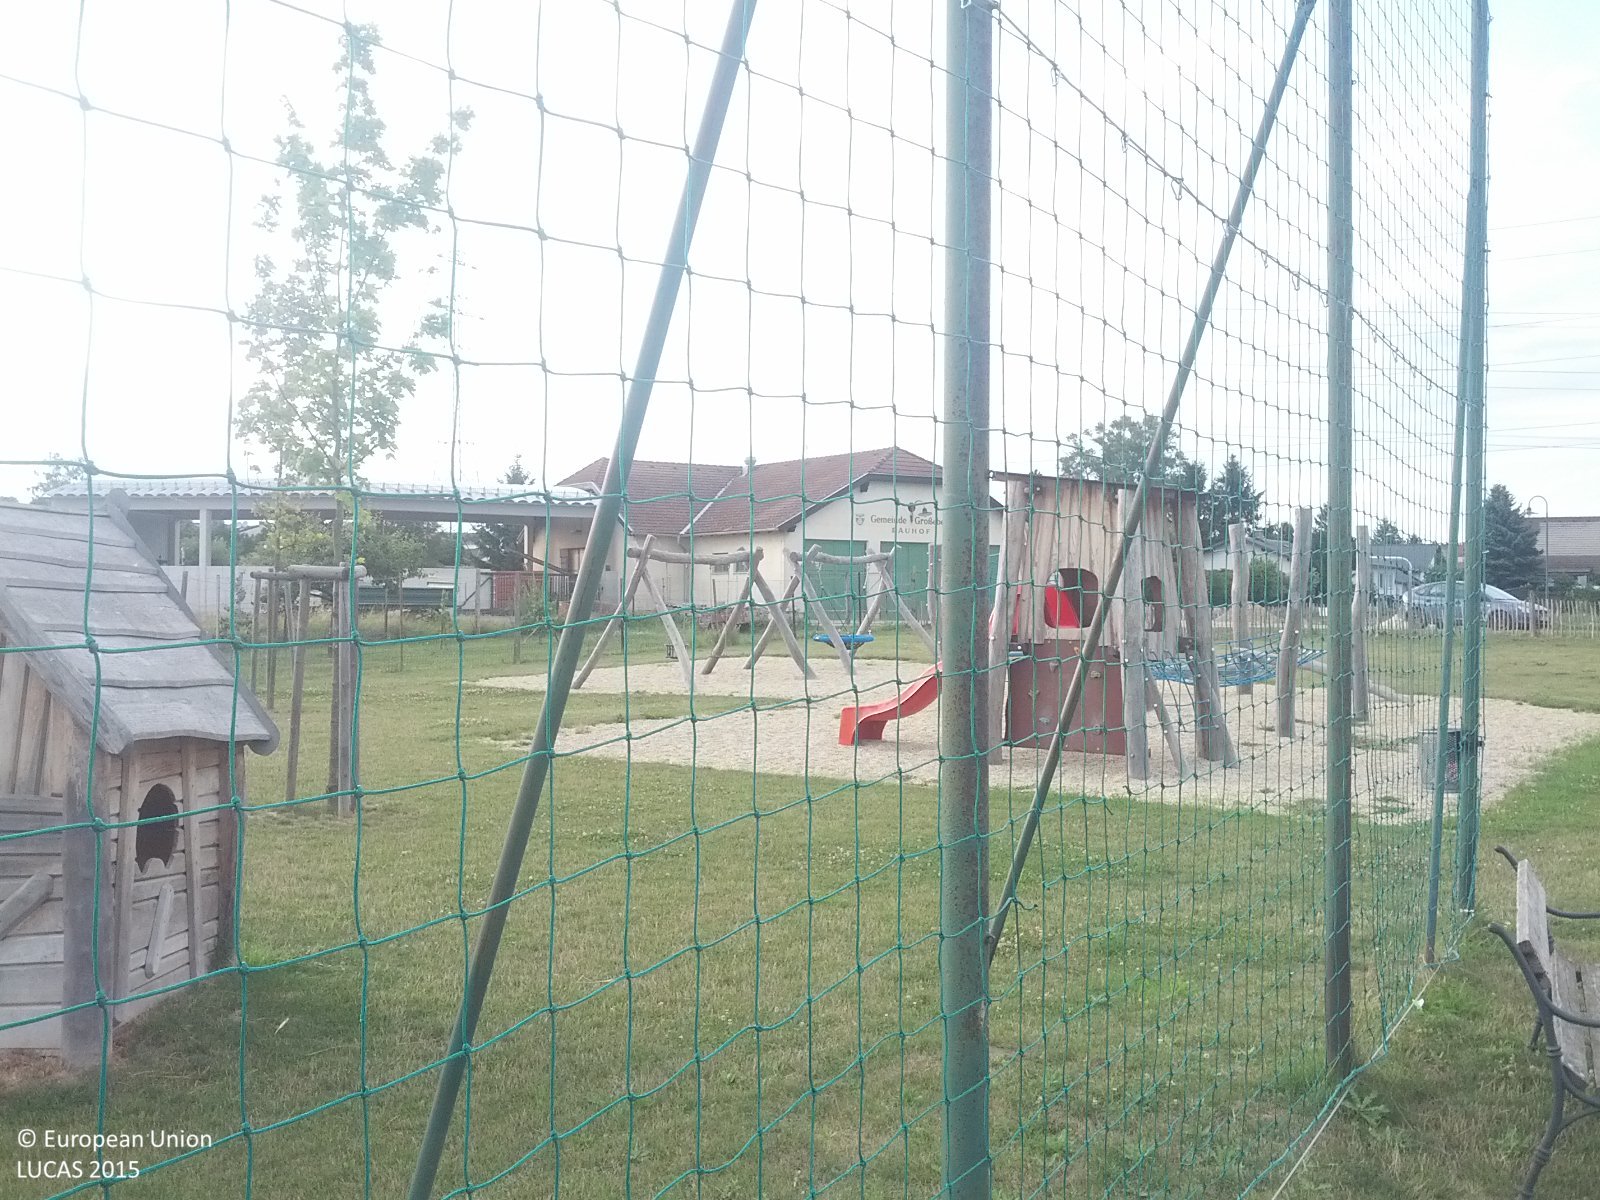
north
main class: Grassland
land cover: Grassland without tree/shrub cover
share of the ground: > 75 %
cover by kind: herbaceous plants 95 %, unconsolidated bare surface 5 %
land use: Sport
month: July
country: AT
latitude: 48.3584
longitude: 16.4703
